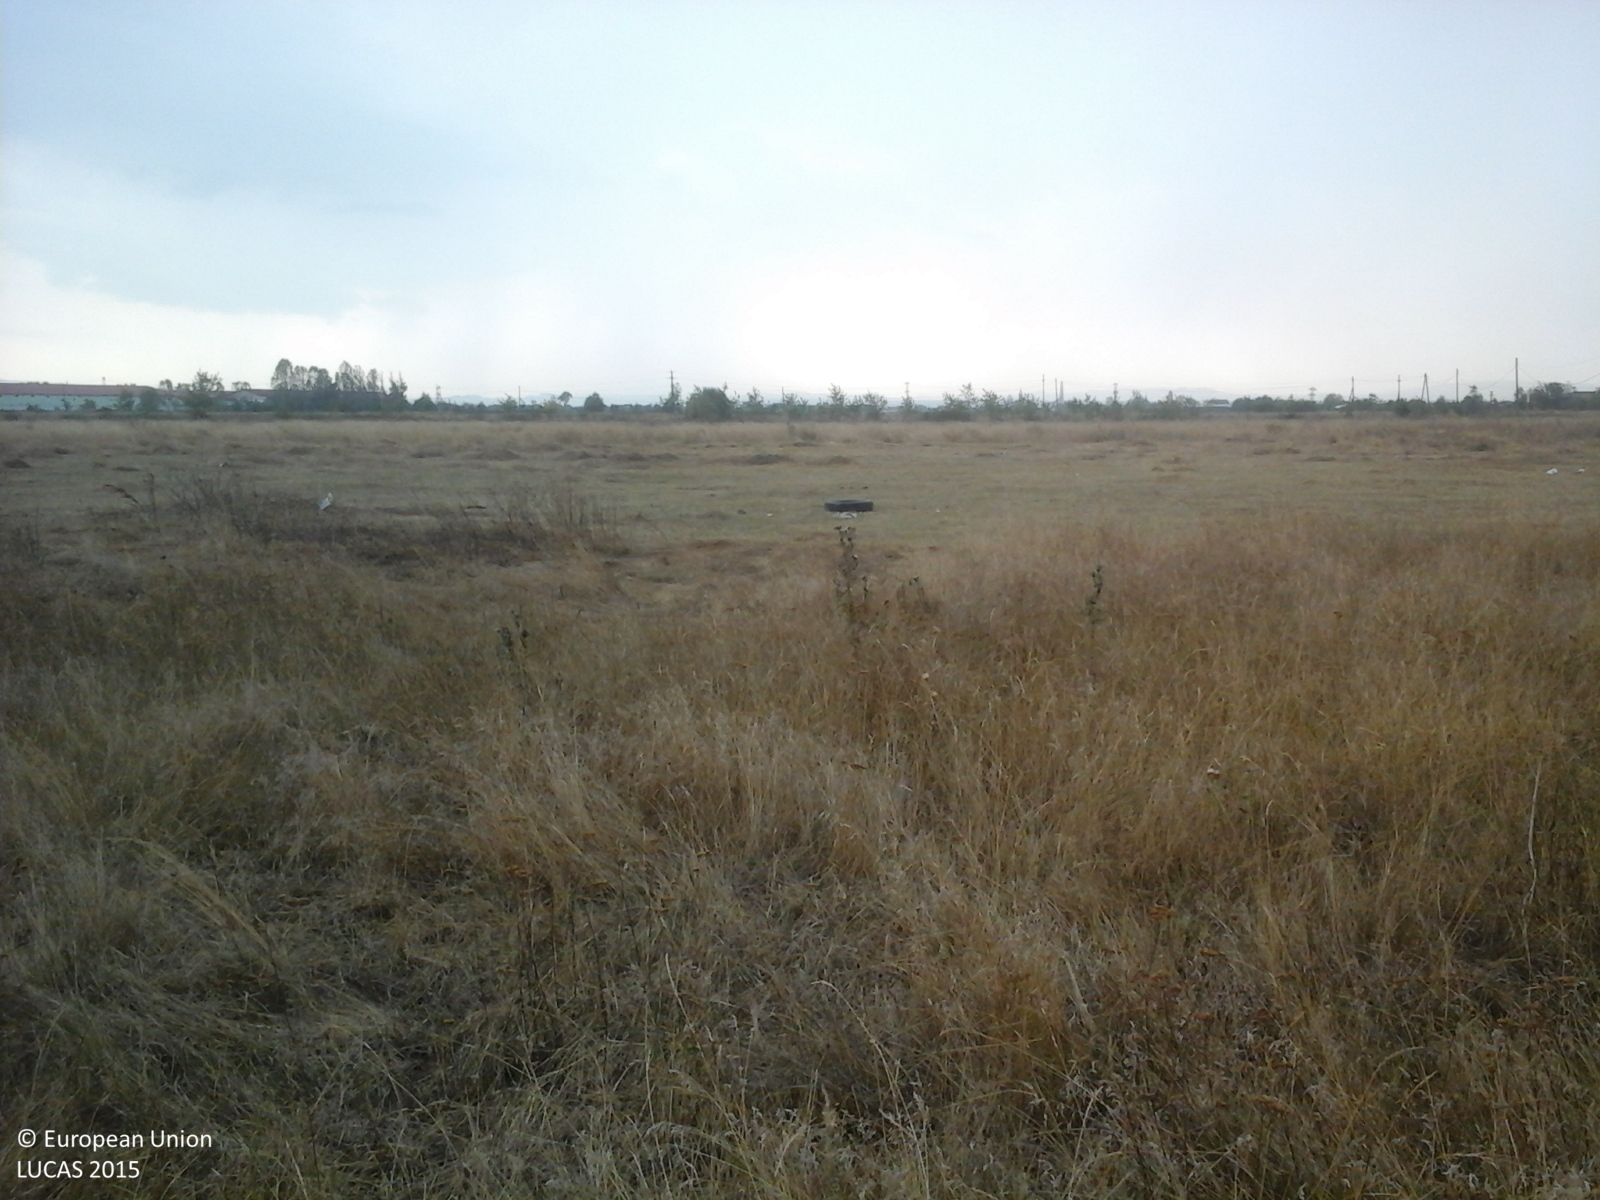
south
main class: Grassland
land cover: Spontaneously vegetated surfaces
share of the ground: > 75 %
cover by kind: herbaceous plants 100 %
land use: Agriculture (excluding fallow land and kitchen gardens)
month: September
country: RO
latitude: 47.6398
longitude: 23.5321
